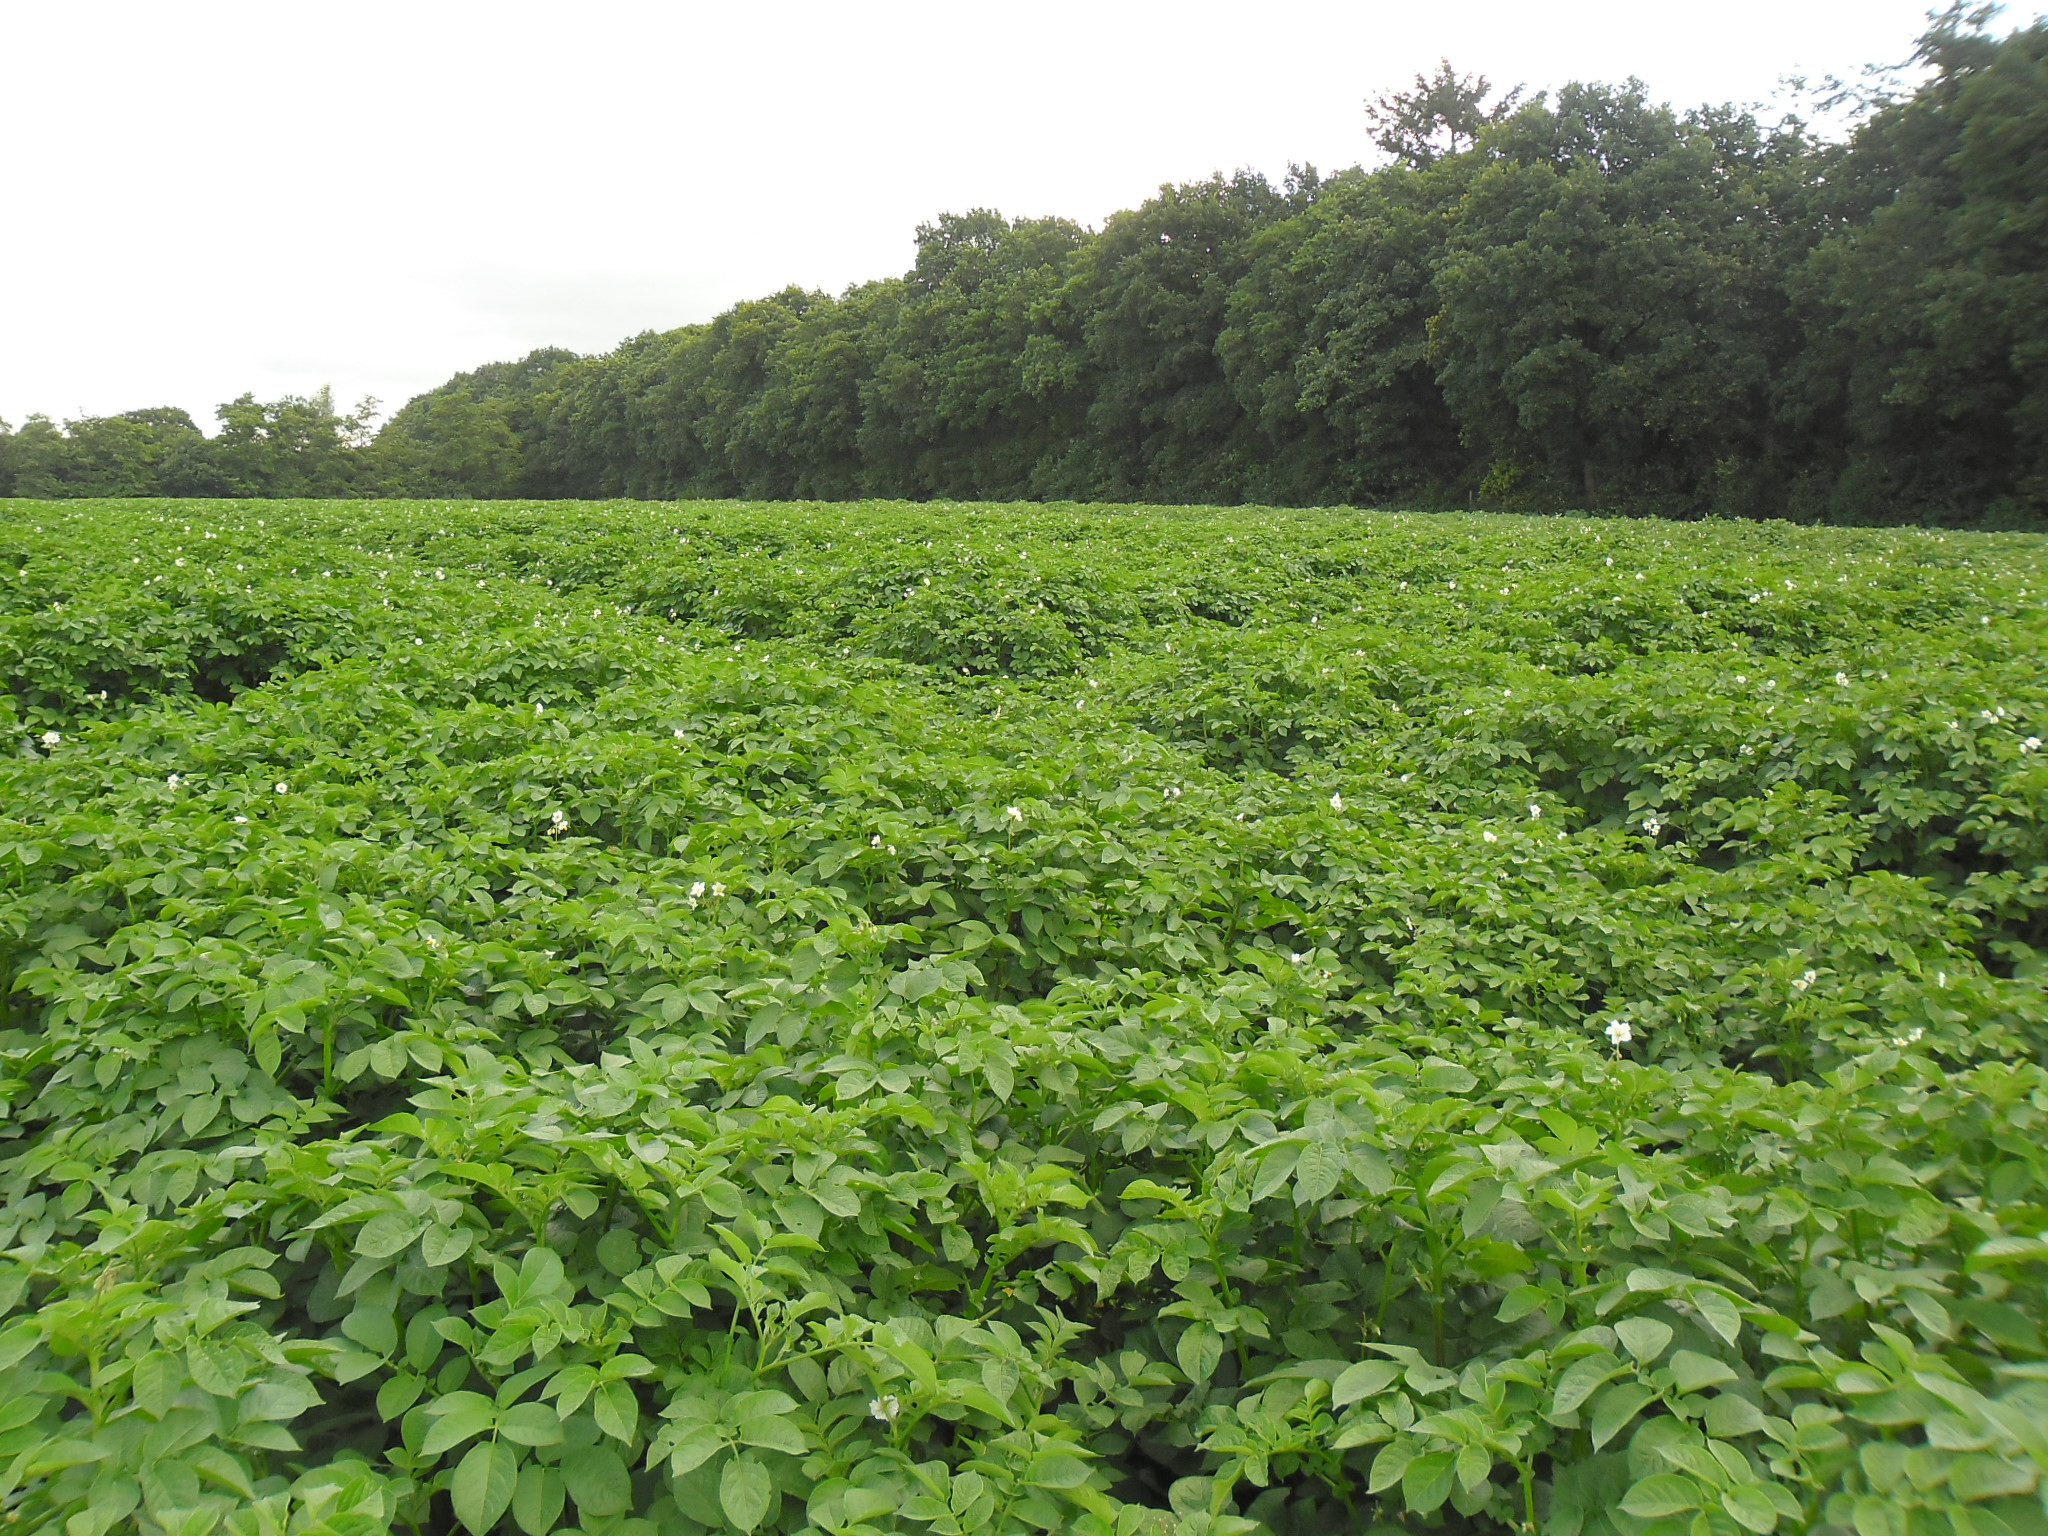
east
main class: Cropland
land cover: Potatoes
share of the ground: > 75 %
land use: Agriculture (excluding fallow land and kitchen gardens)
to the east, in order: Potatoes; Broadleaved woodland; Grassland without tree/shrub cover; Broadleaved woodland; Tracks; Broadleaved woodland; Other coniferous woodland
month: July
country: NL
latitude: 52.8538
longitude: 6.7182
